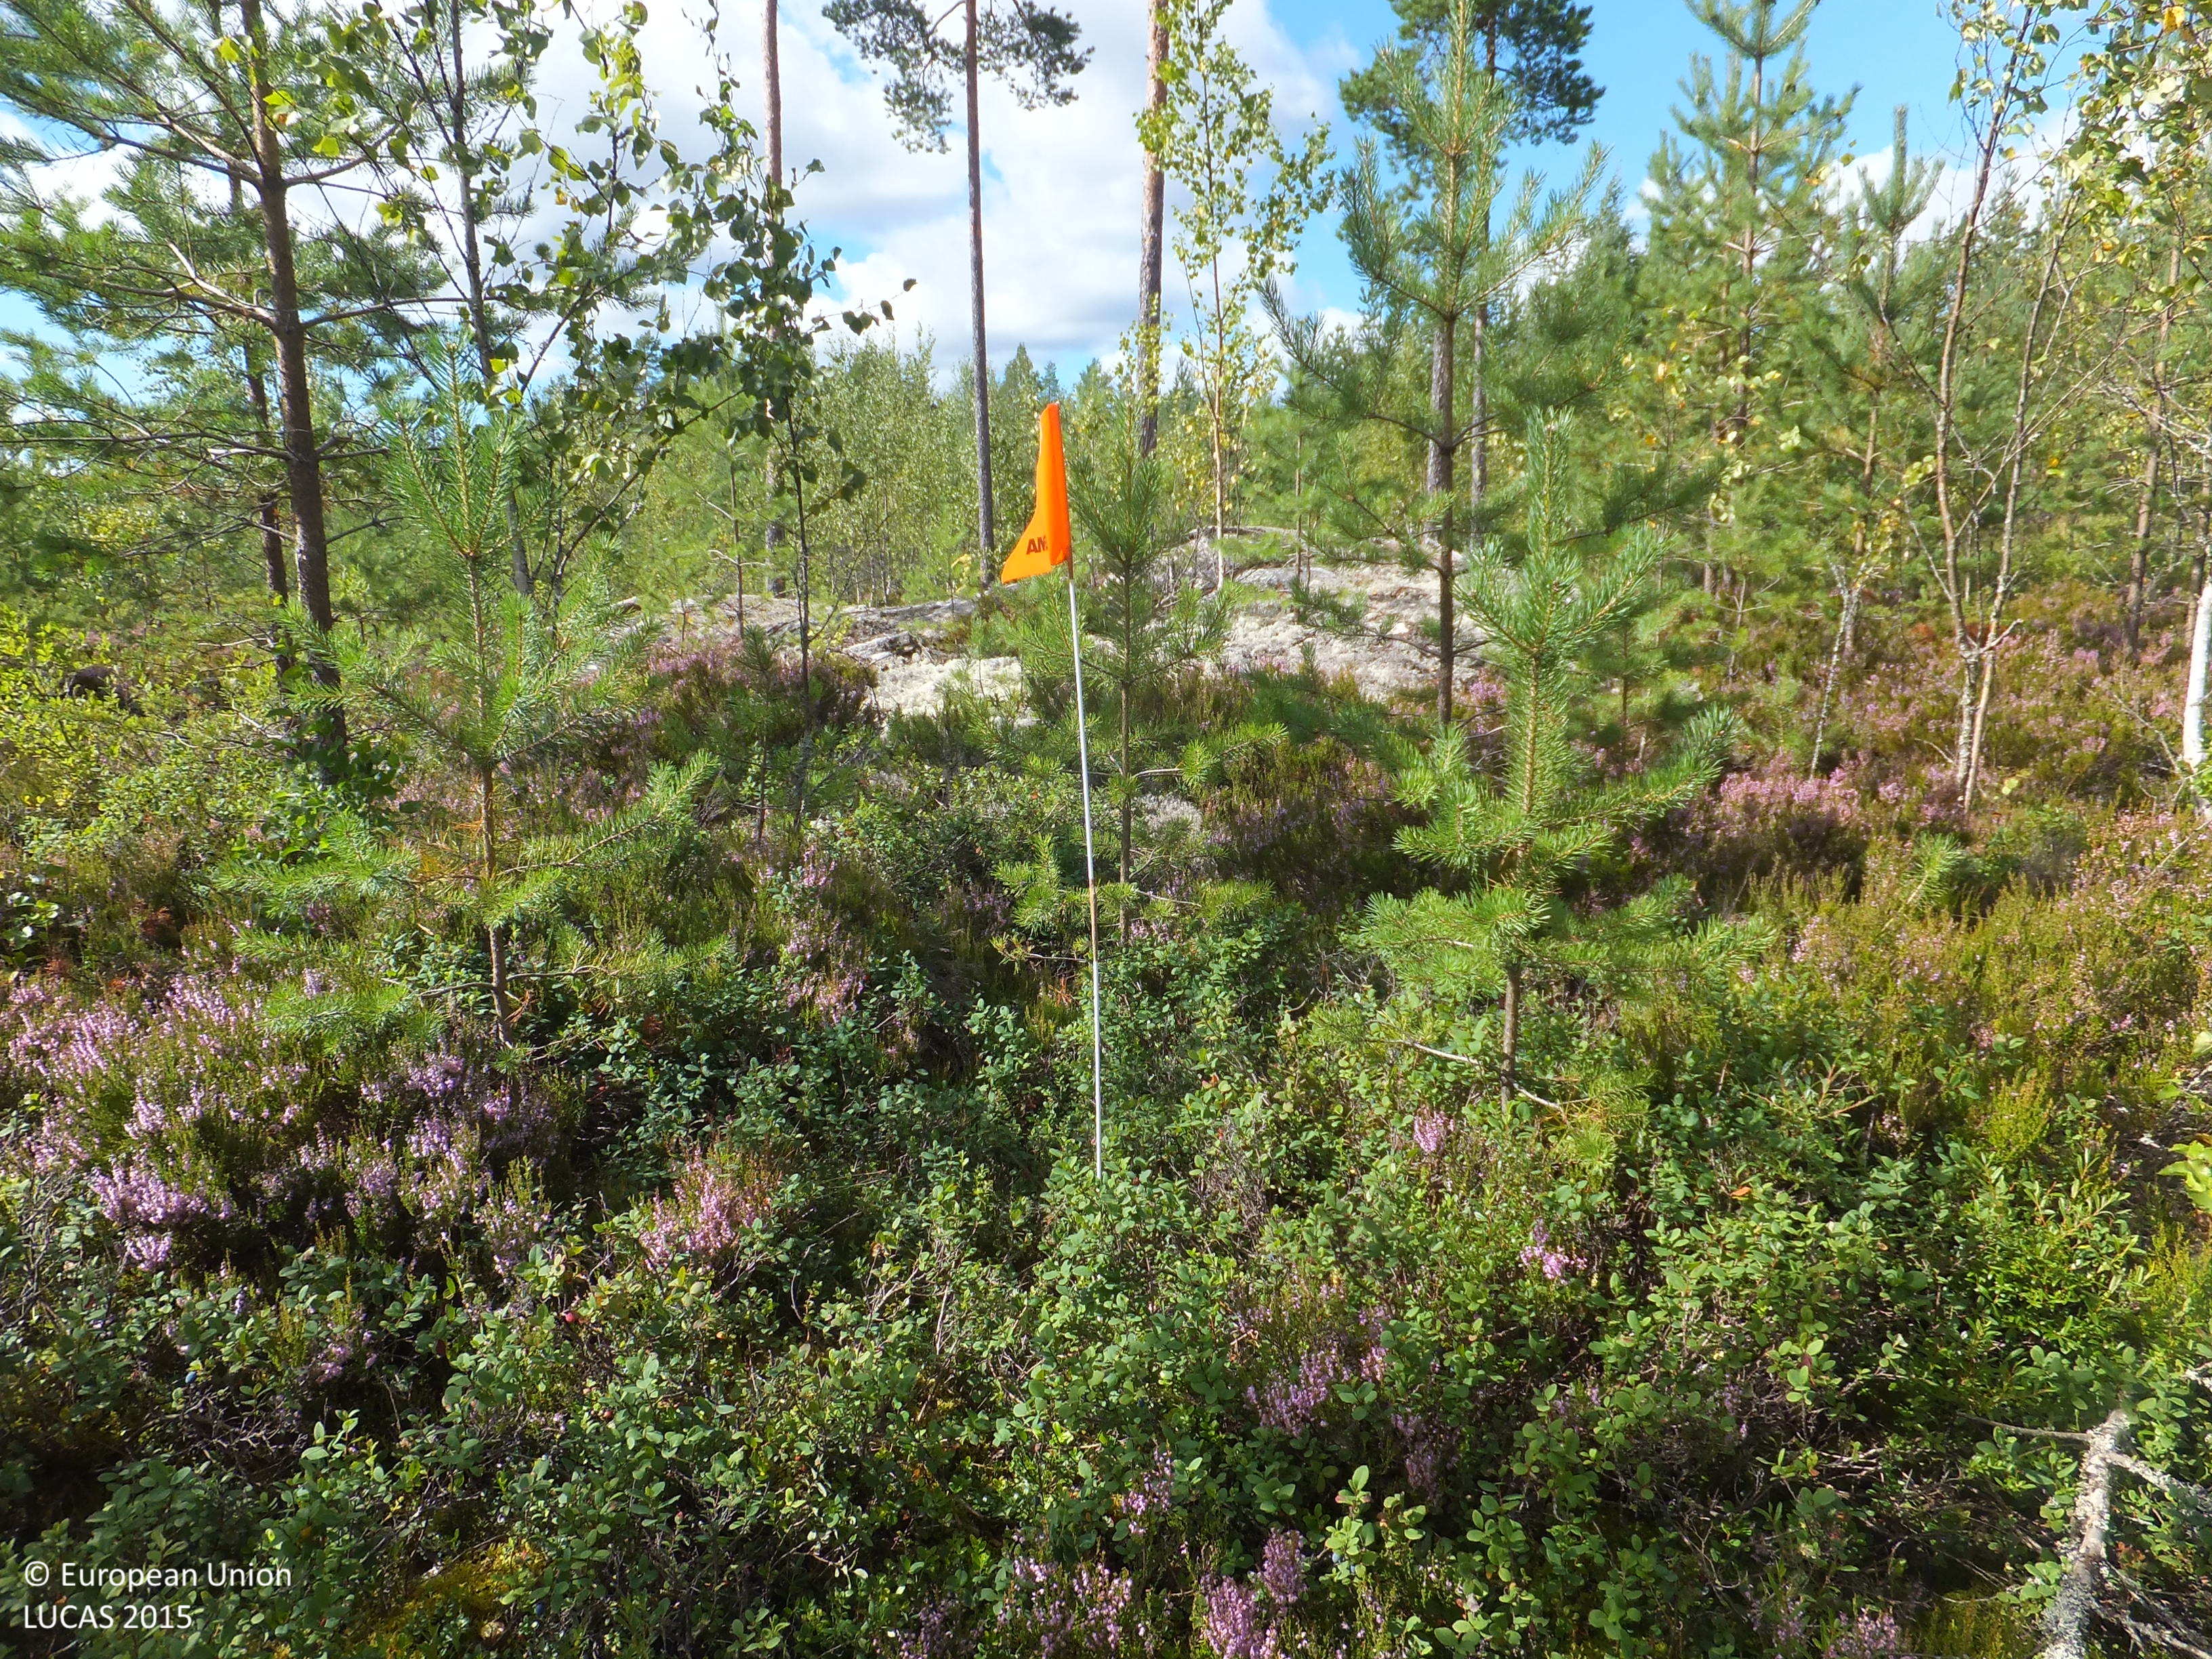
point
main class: Woodland
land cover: Pine dominated mixed woodland
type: boreal forest
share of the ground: 25 - 50 %
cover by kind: shrubs 30 %, coniferous forest trees 20 %, broadleaved forest trees 20 %, lichens and mosses 20 %, herbaceous plants 5 %, consolidated bare surface 5 %
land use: Forestry
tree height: < 5 m
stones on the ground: 10 - 25 %
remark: Nursery
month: August
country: FI
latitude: 63.2634
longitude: 22.9055
